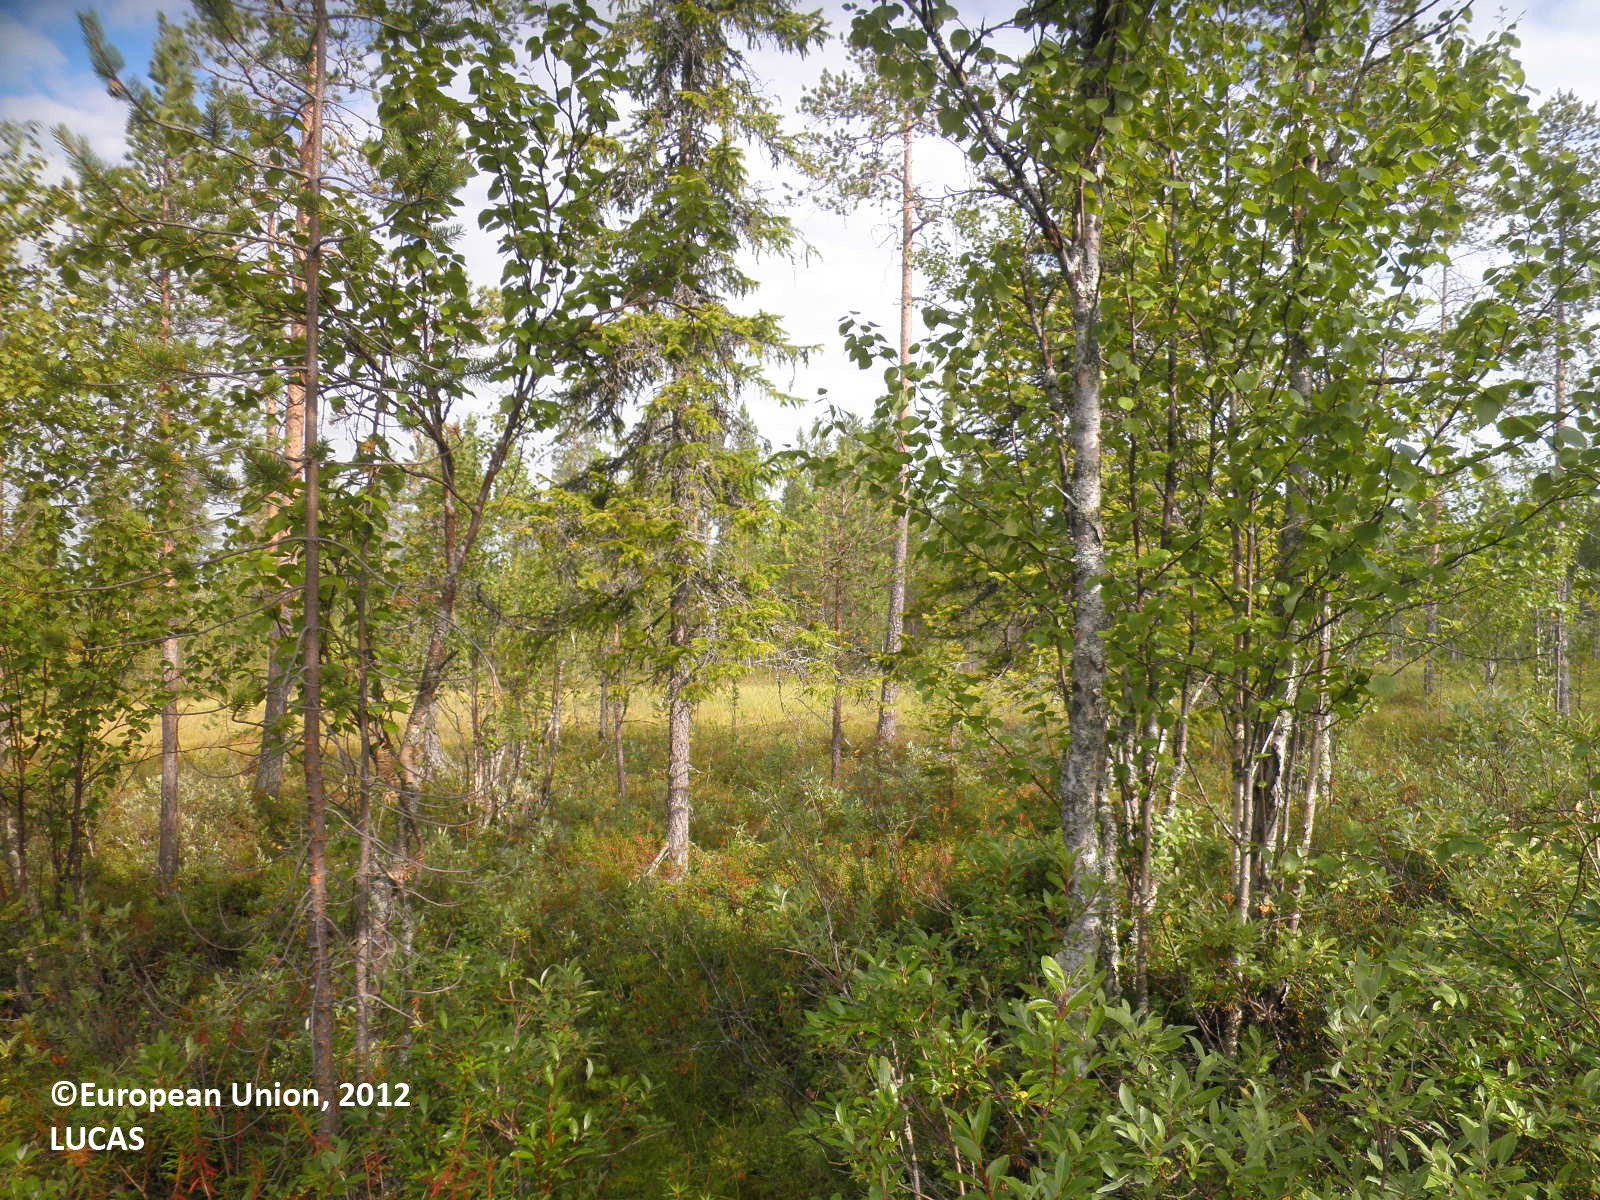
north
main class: Woodland
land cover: Pine dominated mixed woodland
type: boreal forest
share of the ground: 25 - 50 %
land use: Forestry
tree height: > 5 m
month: August
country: FI
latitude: 67.5038
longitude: 27.0653
